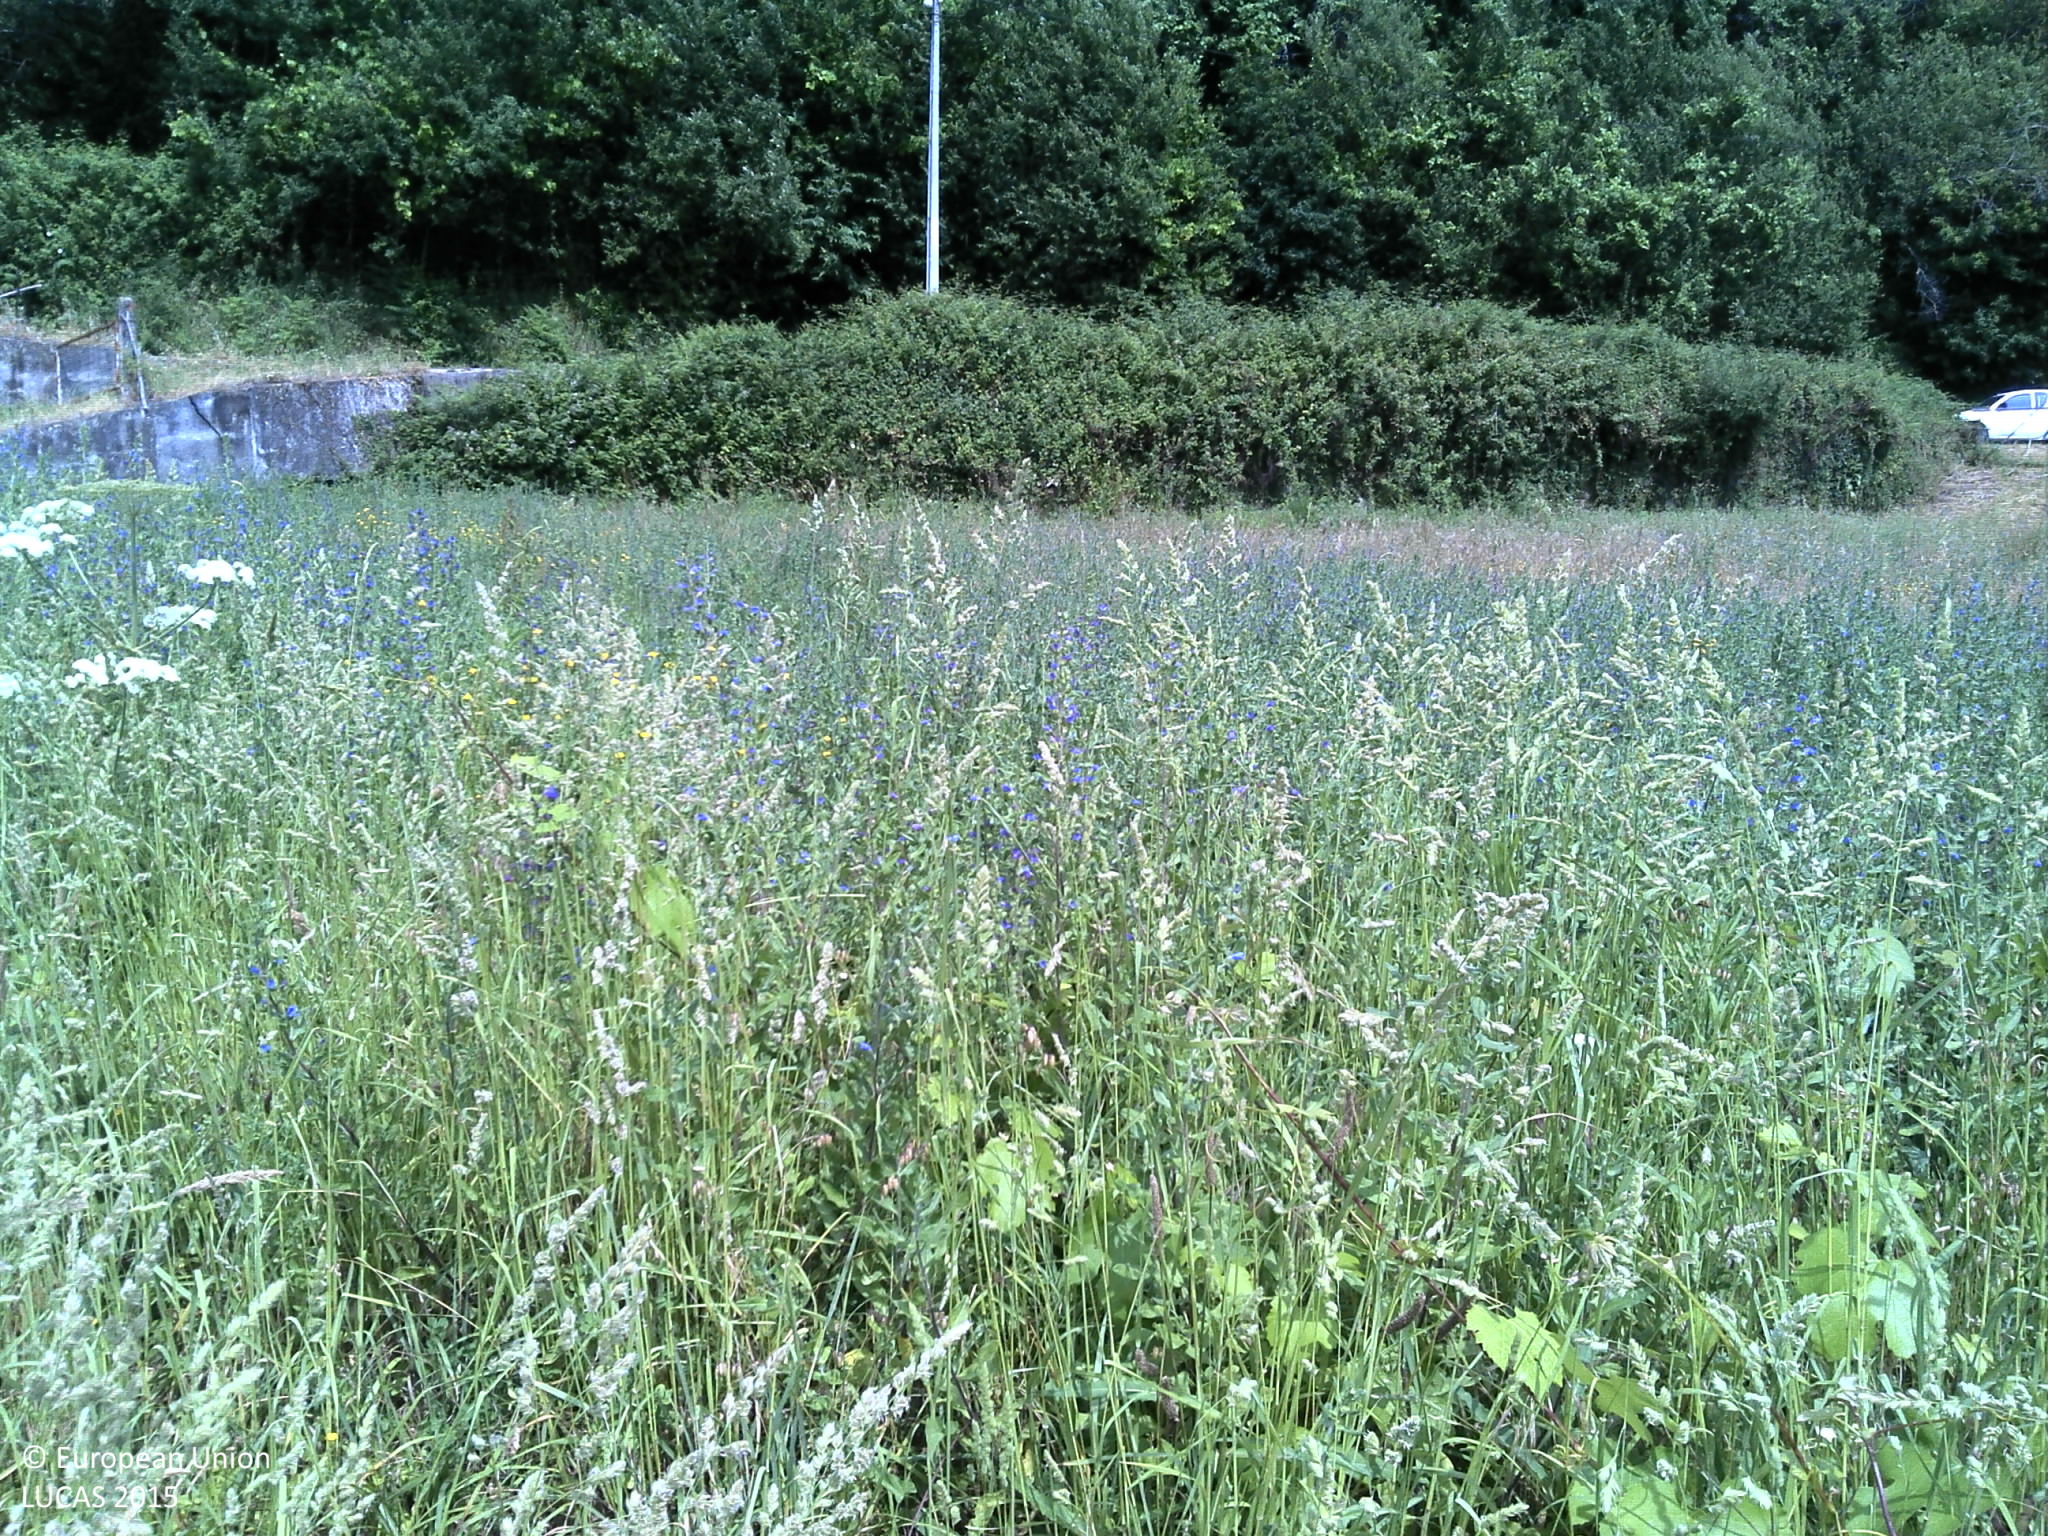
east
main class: Cropland
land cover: Temporary grasslands
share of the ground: > 75 %
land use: Agriculture (excluding fallow land and kitchen gardens)
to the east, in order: Temporary grasslands; Grassland without tree/shrub cover; Dry stone walls; Shrubland without tree cover; Electric lines; Paved roads, cycling and walking lanes; Broadleaved woodland; Dry stone walls; Spontaneously vegetated surfaces; Dry stone walls; Tracks; Dry stone walls; Shrubland without tree cover; Dry stone walls; Vineyards; Other fruit trees and berries; Other fresh vegetables; Other fruit trees and berries
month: June
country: PT
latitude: 41.7808
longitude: -8.4090
